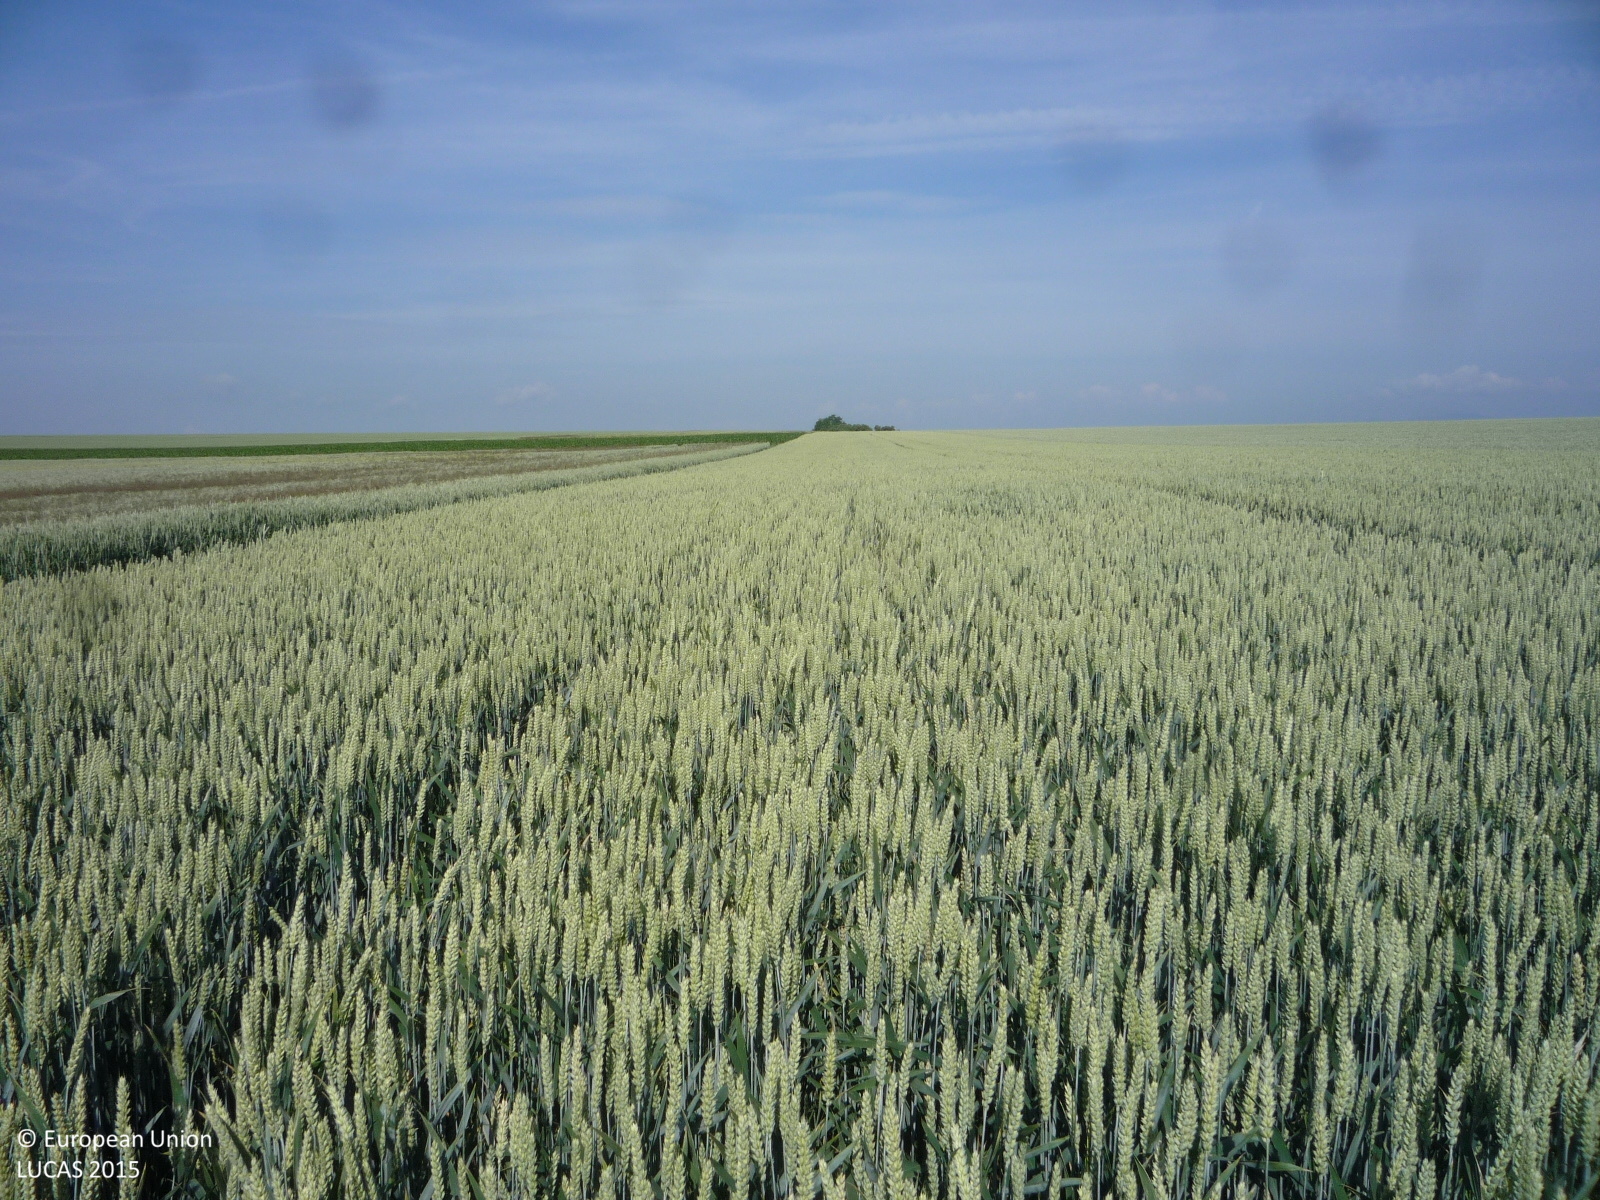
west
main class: Cropland
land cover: Common wheat
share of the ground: > 75 %
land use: Agriculture (excluding fallow land and kitchen gardens)
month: June
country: CZ
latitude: 50.3778
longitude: 14.1776
